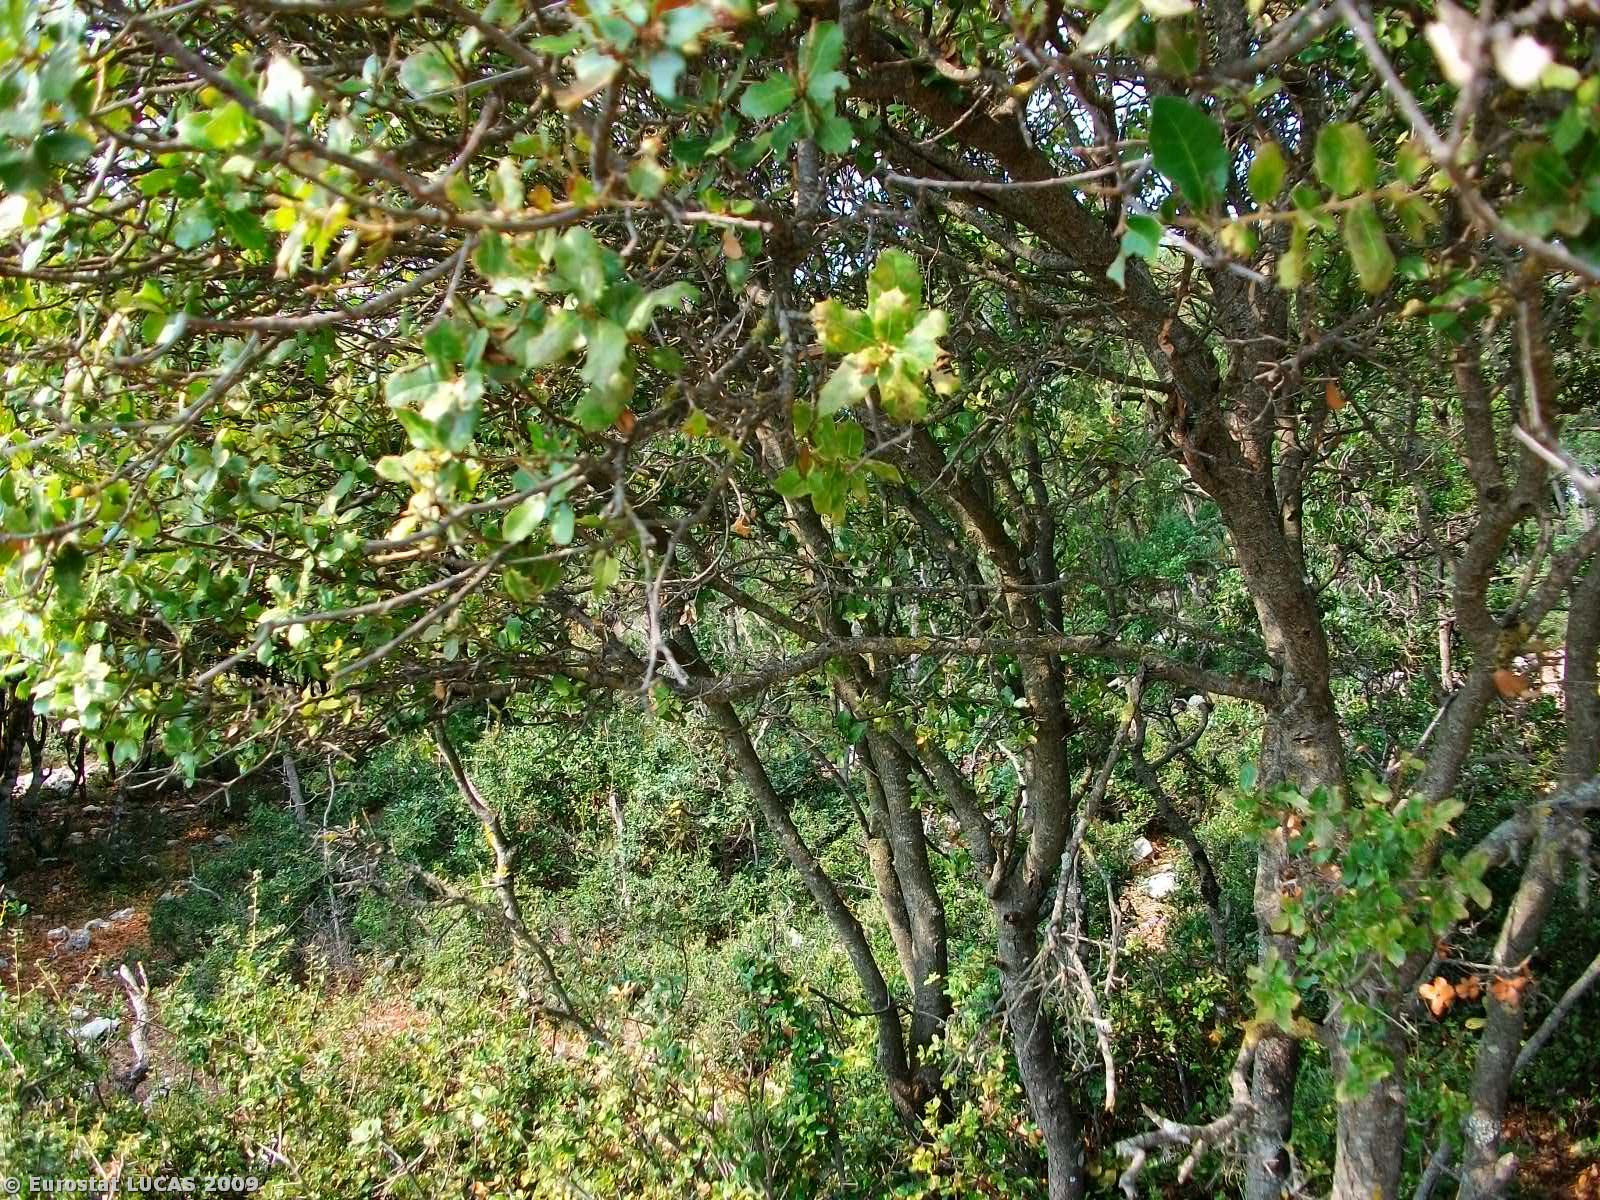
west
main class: Shrubland
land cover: Shrubland with sparse tree cover
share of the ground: 50 - 75 %
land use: Agriculture (excluding fallow land and kitchen gardens)
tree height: < 5 m
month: October
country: GR
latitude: 39.3584
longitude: 20.4762
